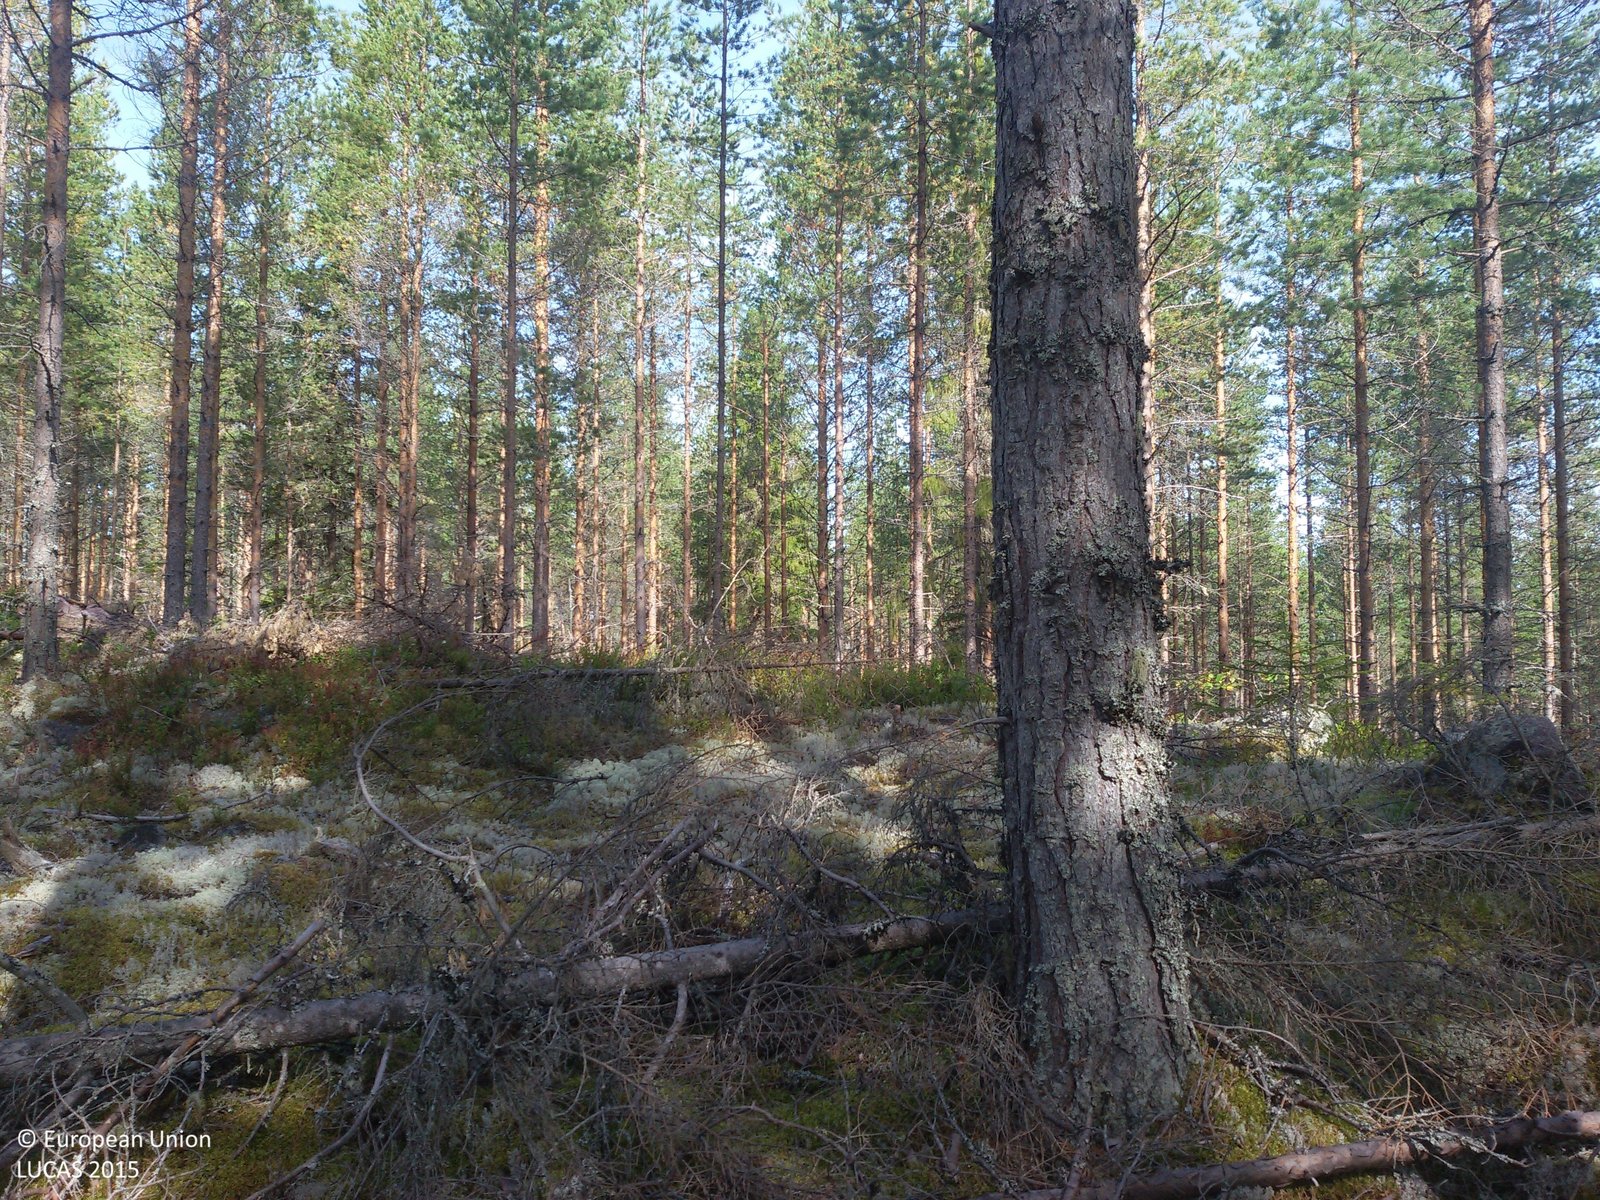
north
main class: Woodland
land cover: Pine dominated coniferous woodland
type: boreal forest
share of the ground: 50 - 75 %
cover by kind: coniferous forest trees 60 %, lichens and mosses 30 %, shrubs 10 %
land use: Forestry
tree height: > 5 m
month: September
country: SE
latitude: 61.0212
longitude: 15.2593
